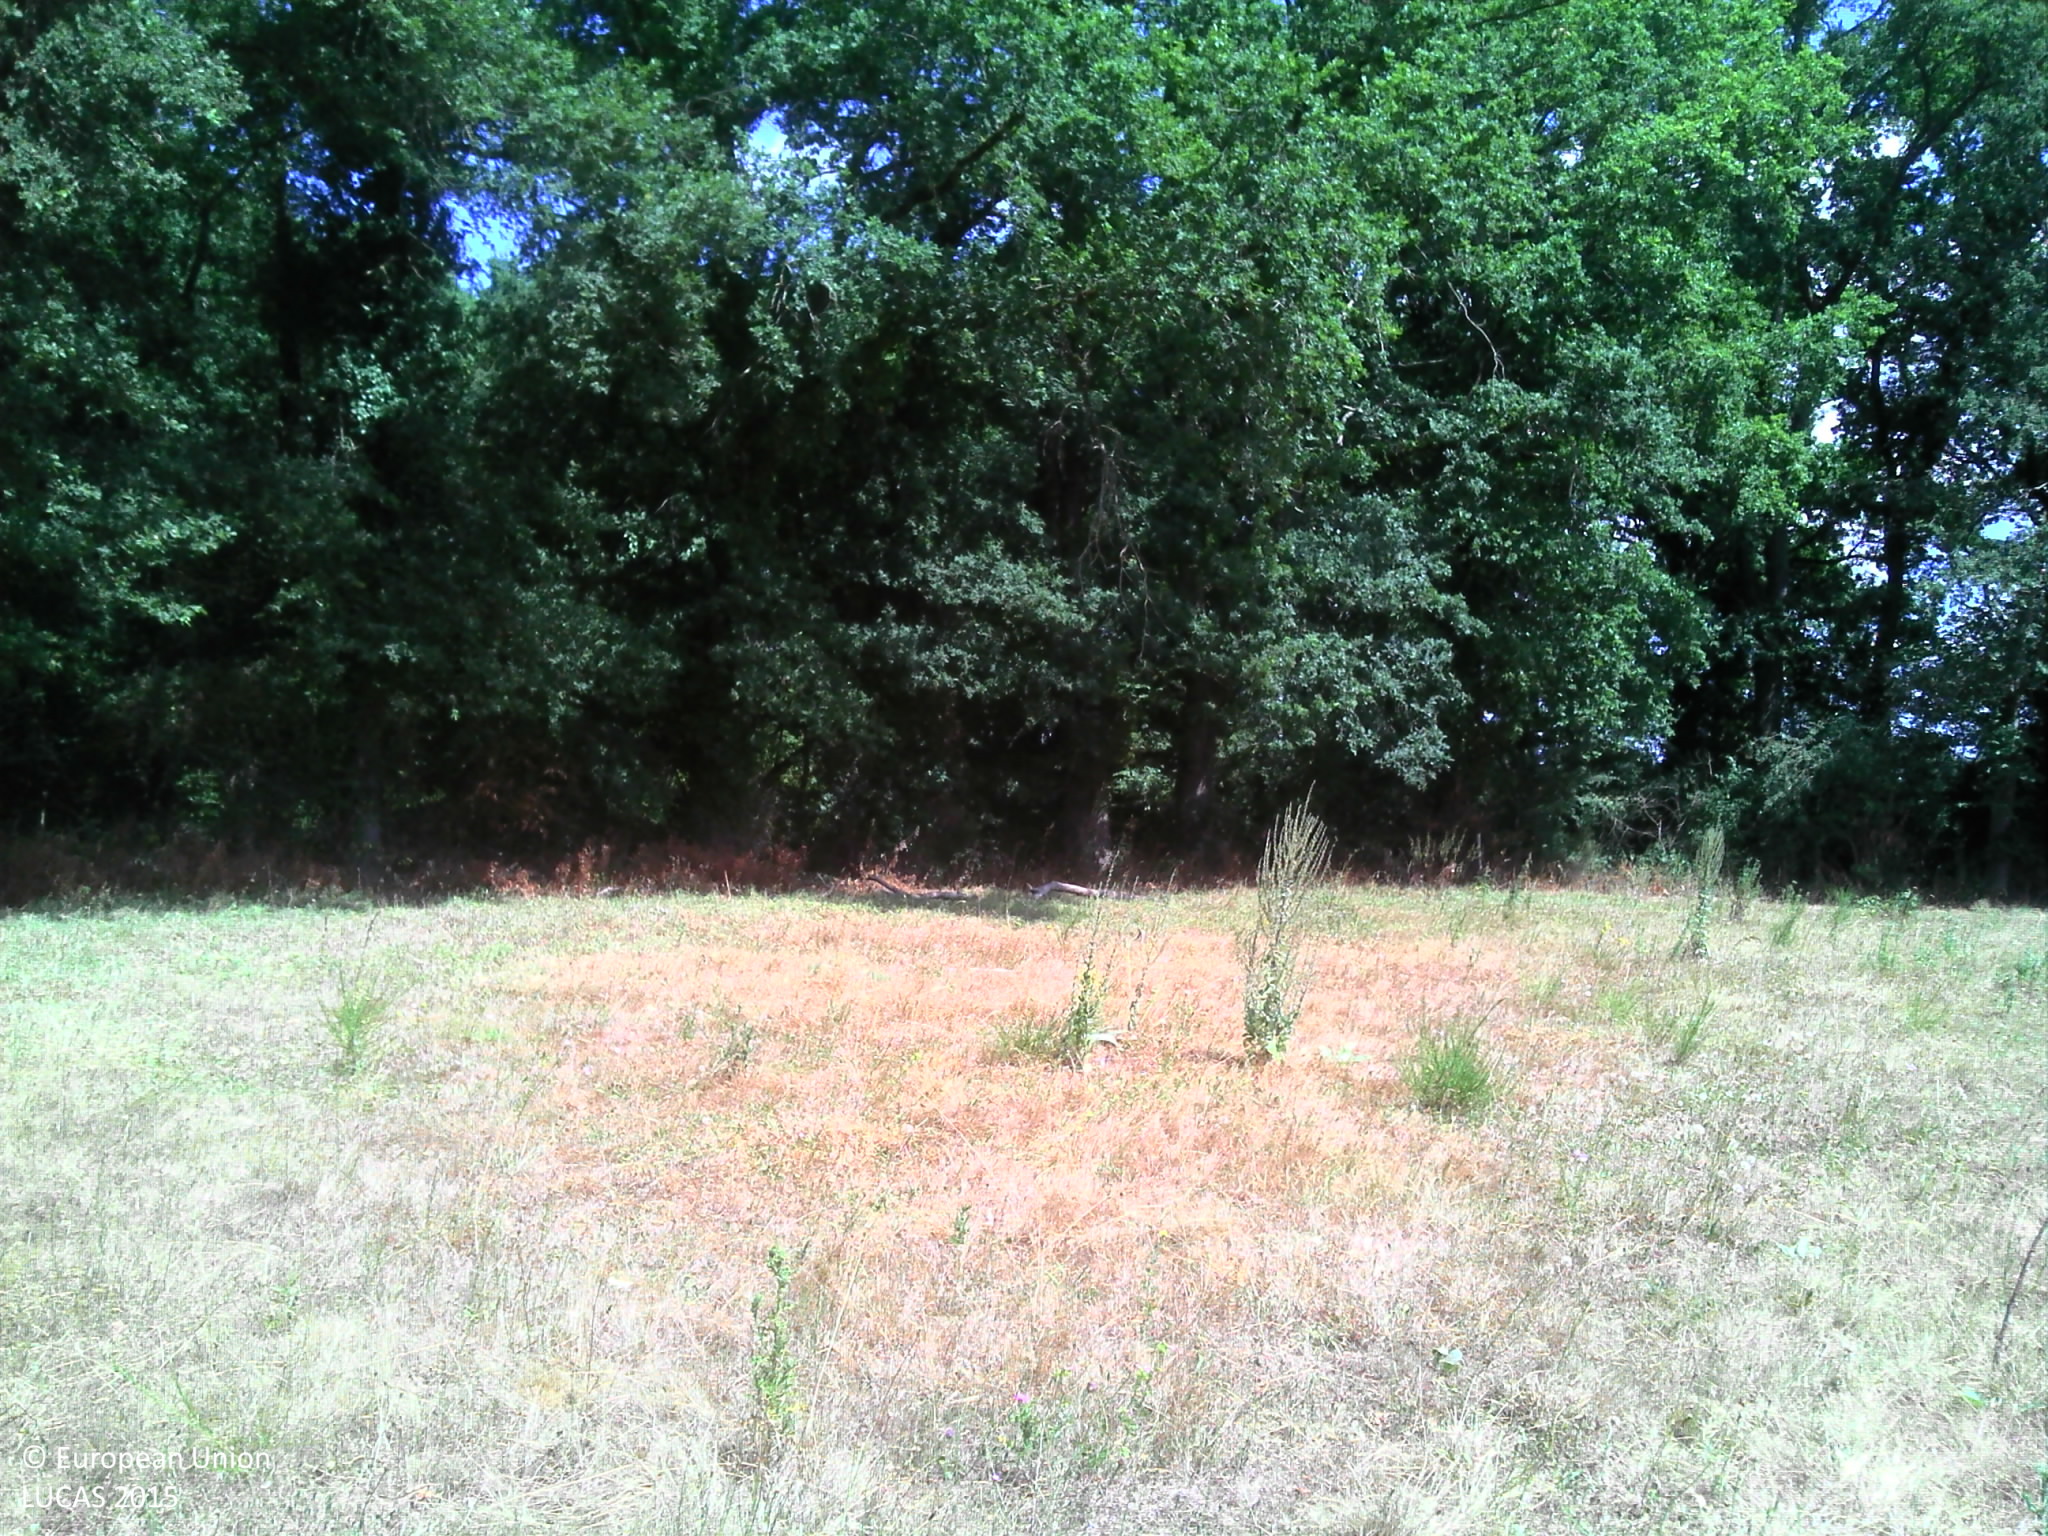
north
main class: Grassland
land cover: Grassland without tree/shrub cover
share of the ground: > 75 %
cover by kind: herbaceous plants 100 %
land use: Agriculture (excluding fallow land and kitchen gardens)
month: July
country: FR
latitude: 46.4661
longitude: 2.7429
